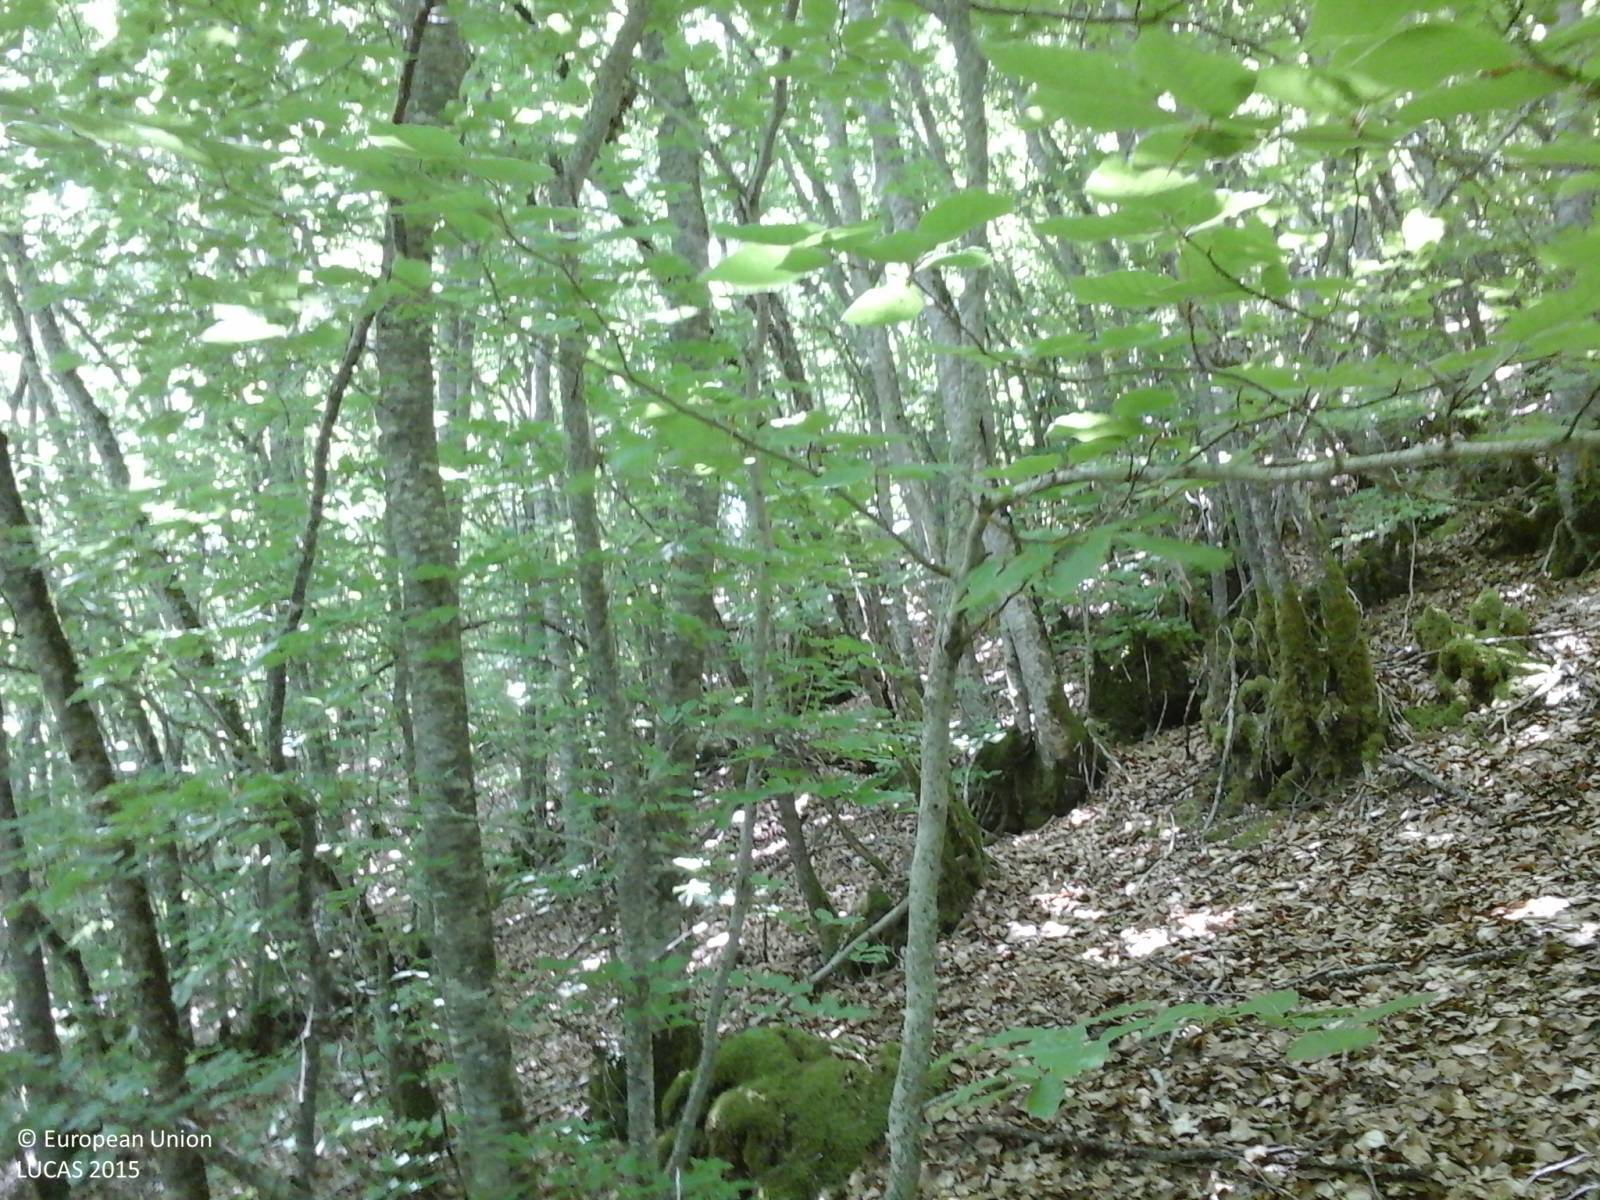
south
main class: Woodland
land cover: Broadleaved woodland
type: mountainous beech forest
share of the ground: > 75 %
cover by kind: broadleaved forest trees 100 %
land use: Forestry
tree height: > 5 m
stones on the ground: < 10 %
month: July
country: IT
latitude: 42.4232
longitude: 13.1861
